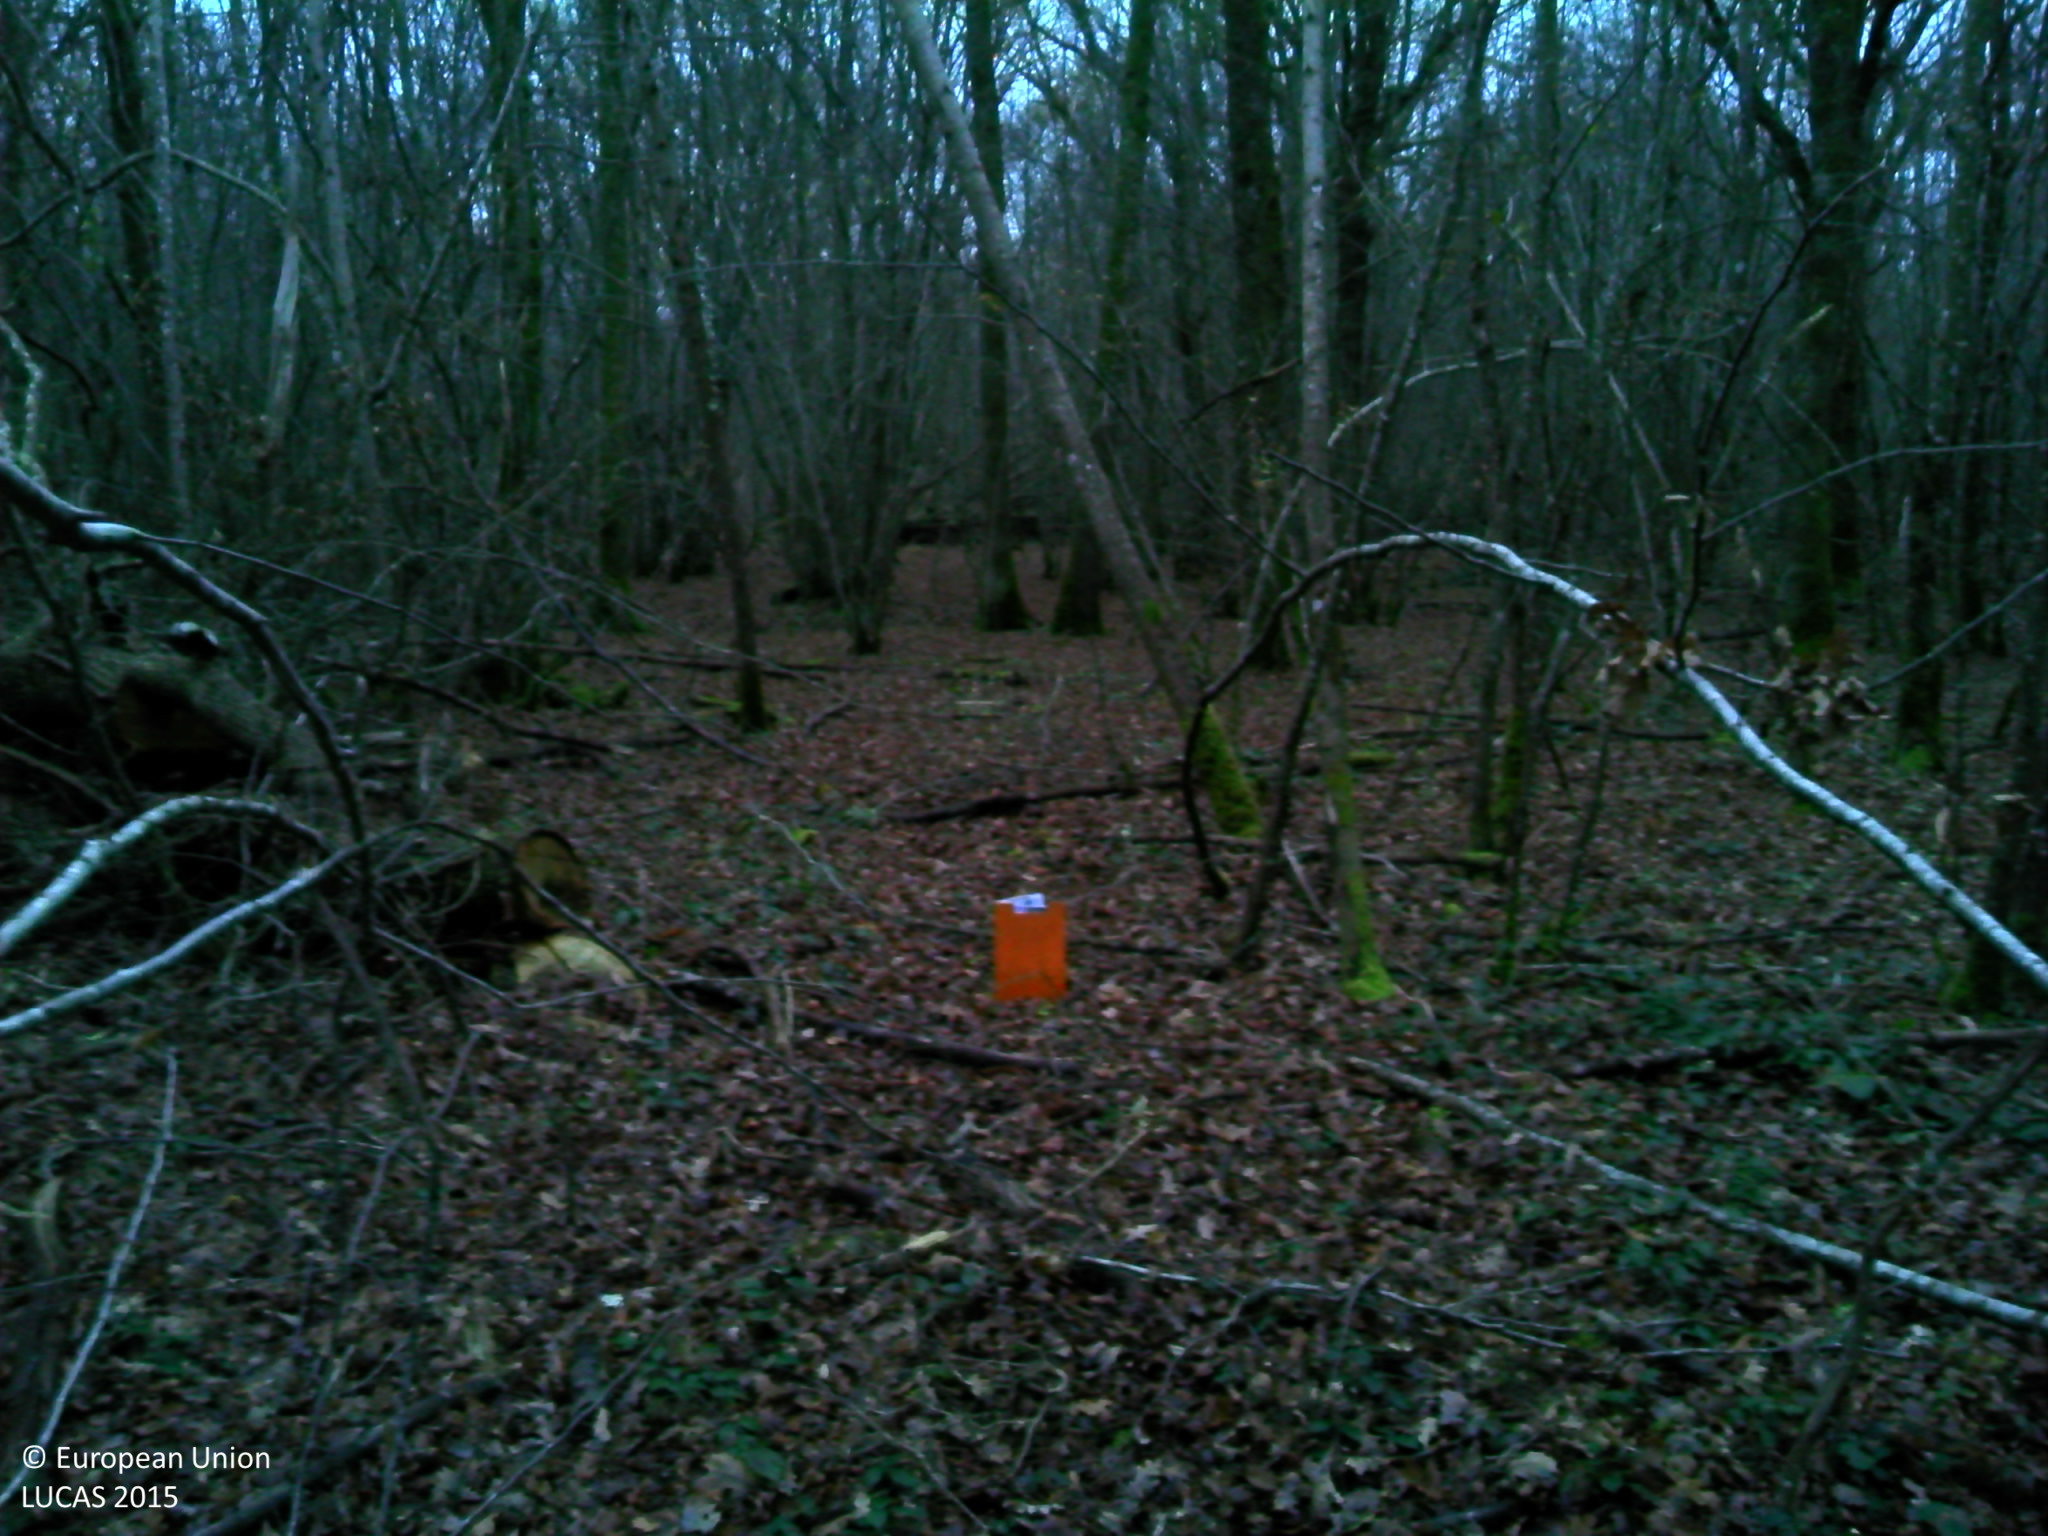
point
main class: Woodland
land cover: Broadleaved woodland
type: acidophilous oak and oak-birch forest
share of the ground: > 75 %
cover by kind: broadleaved forest trees 95 %, shrubs 5 %
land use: Forestry
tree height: > 5 m
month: December
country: FR
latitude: 46.5880
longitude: 3.2241
